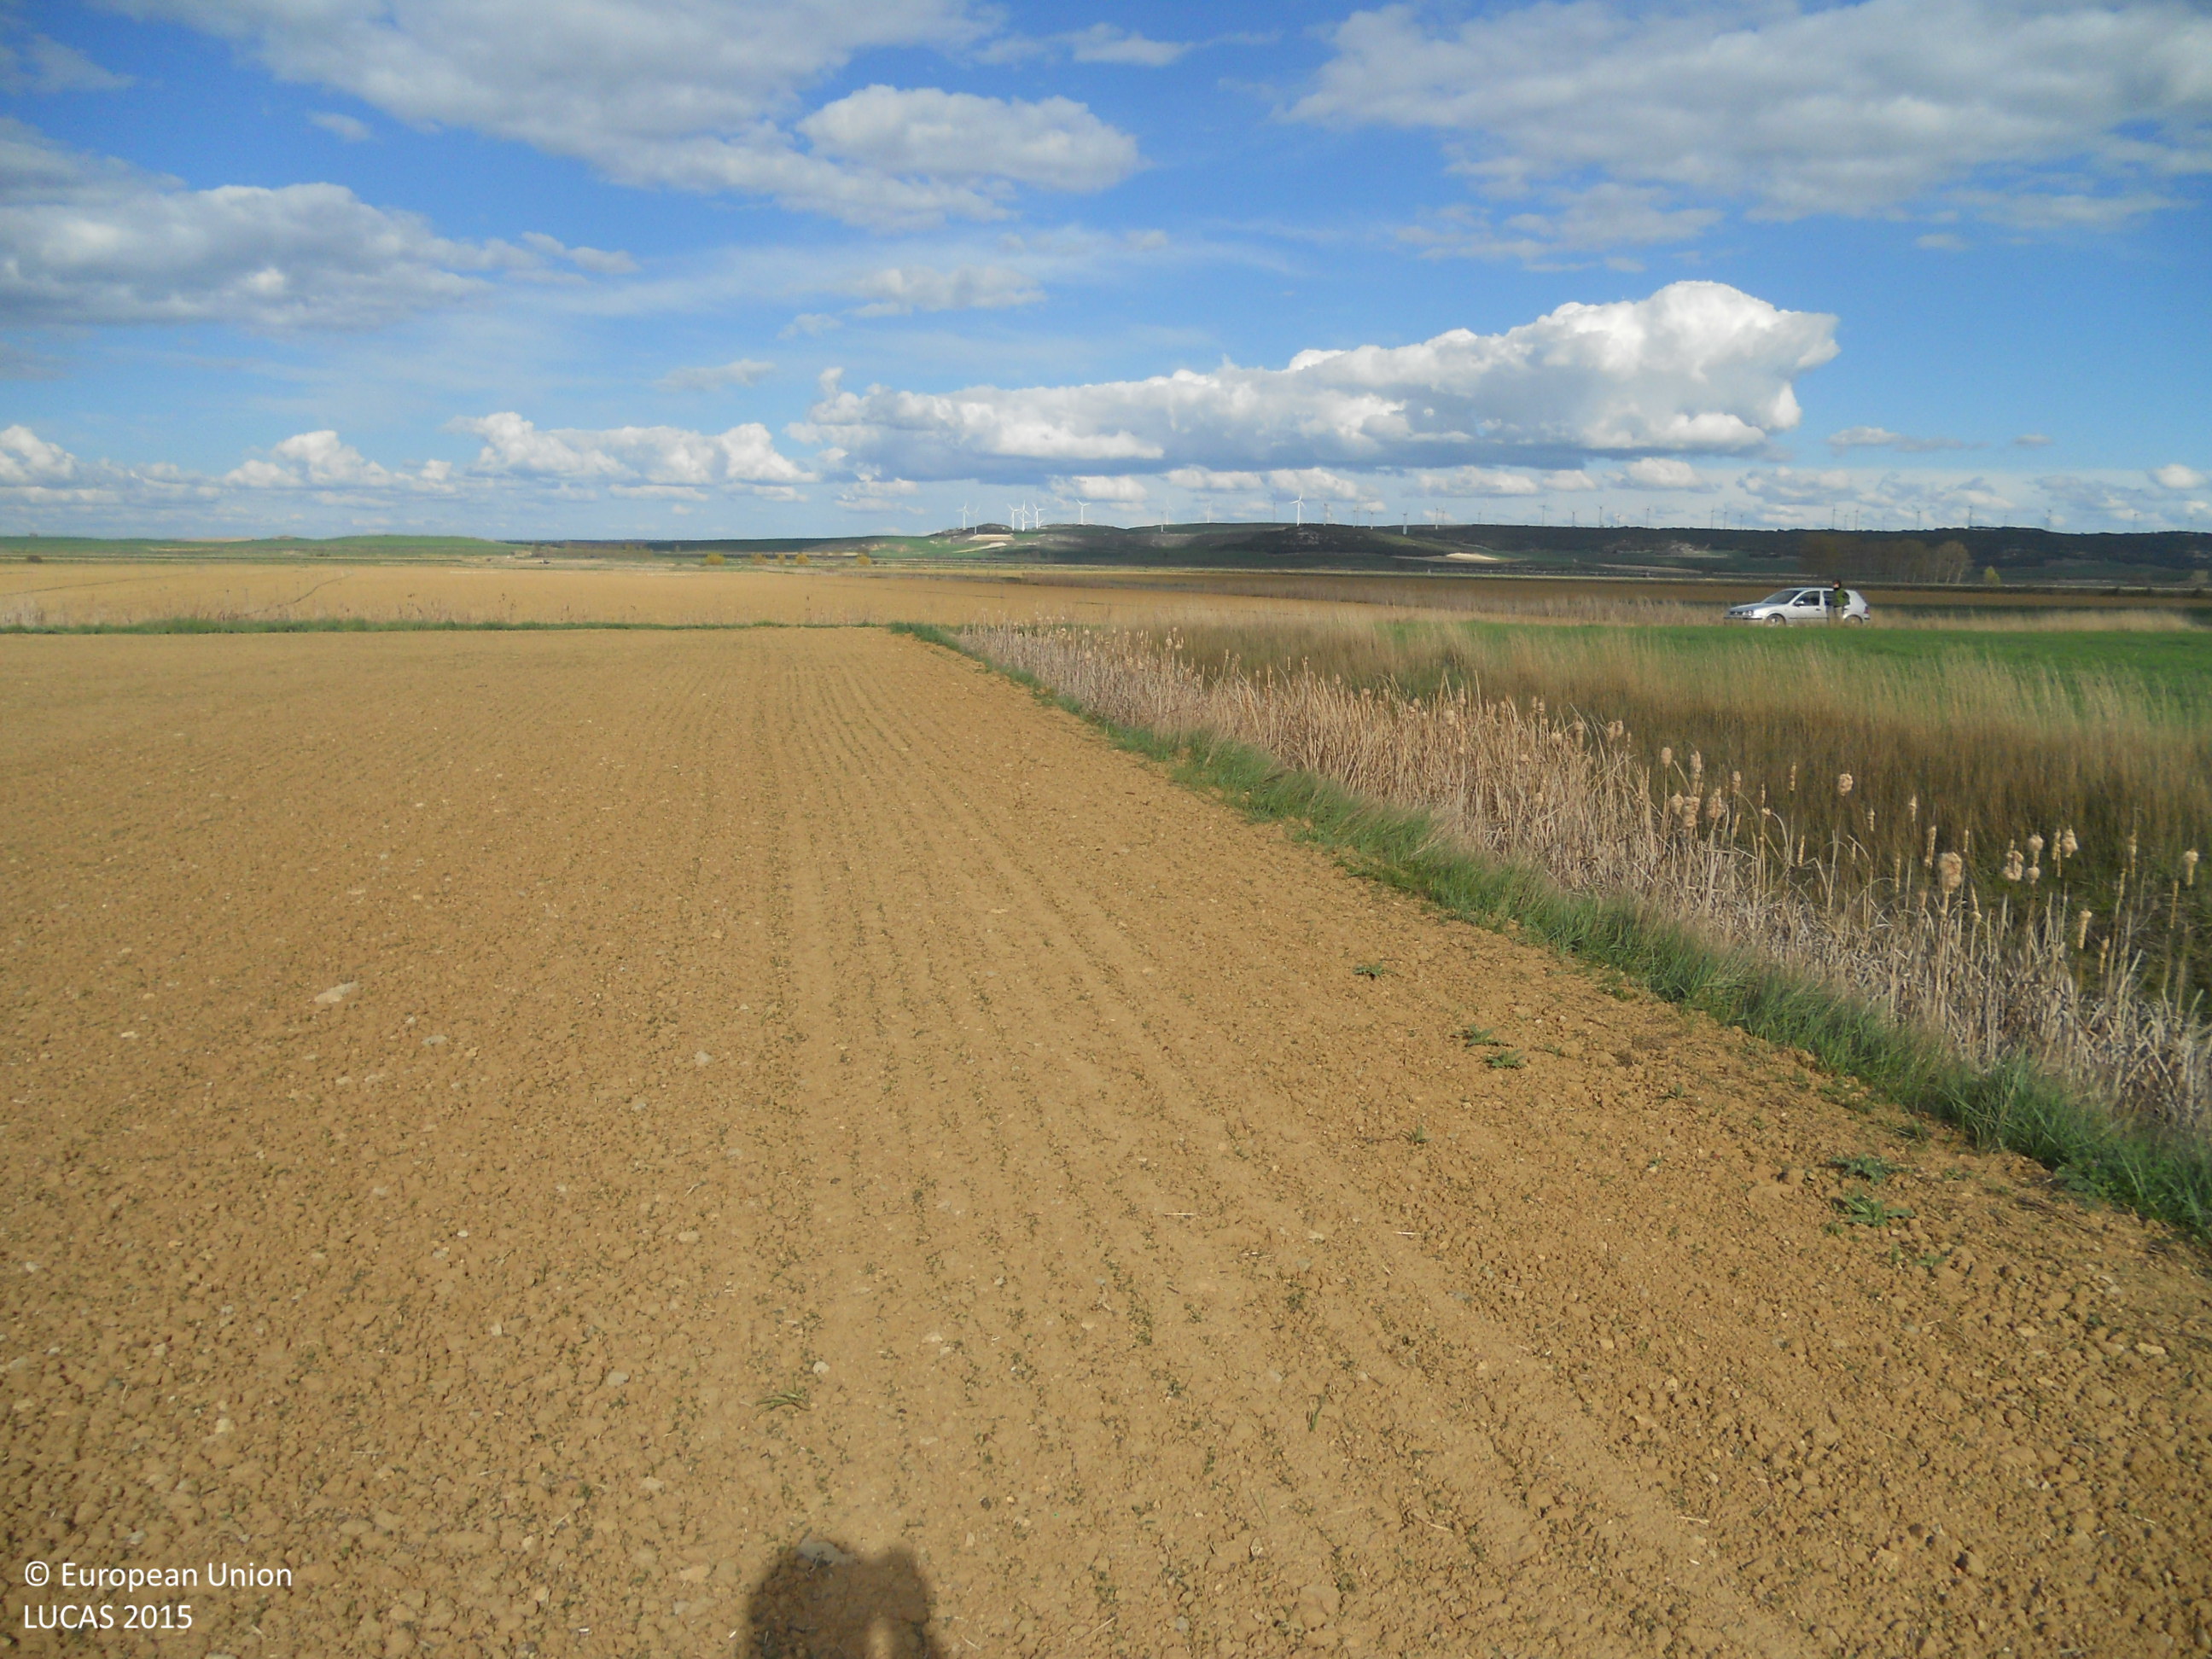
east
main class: Cropland
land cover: Lucerne
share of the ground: < 10 %
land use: Agriculture (excluding fallow land and kitchen gardens)
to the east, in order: Lucerne; Grass margins; Ditches and canals; Grass margins; Barley; Grass margins; Tracks; Grass margins; Ditches and canals; Grass margins; Lucerne; Grass margins; Ditches and canals; Grass margins; Tracks; Grass margins; Ditches and canals; Grass margins; Sunflower
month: April
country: ES
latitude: 42.2332
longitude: -4.3313
